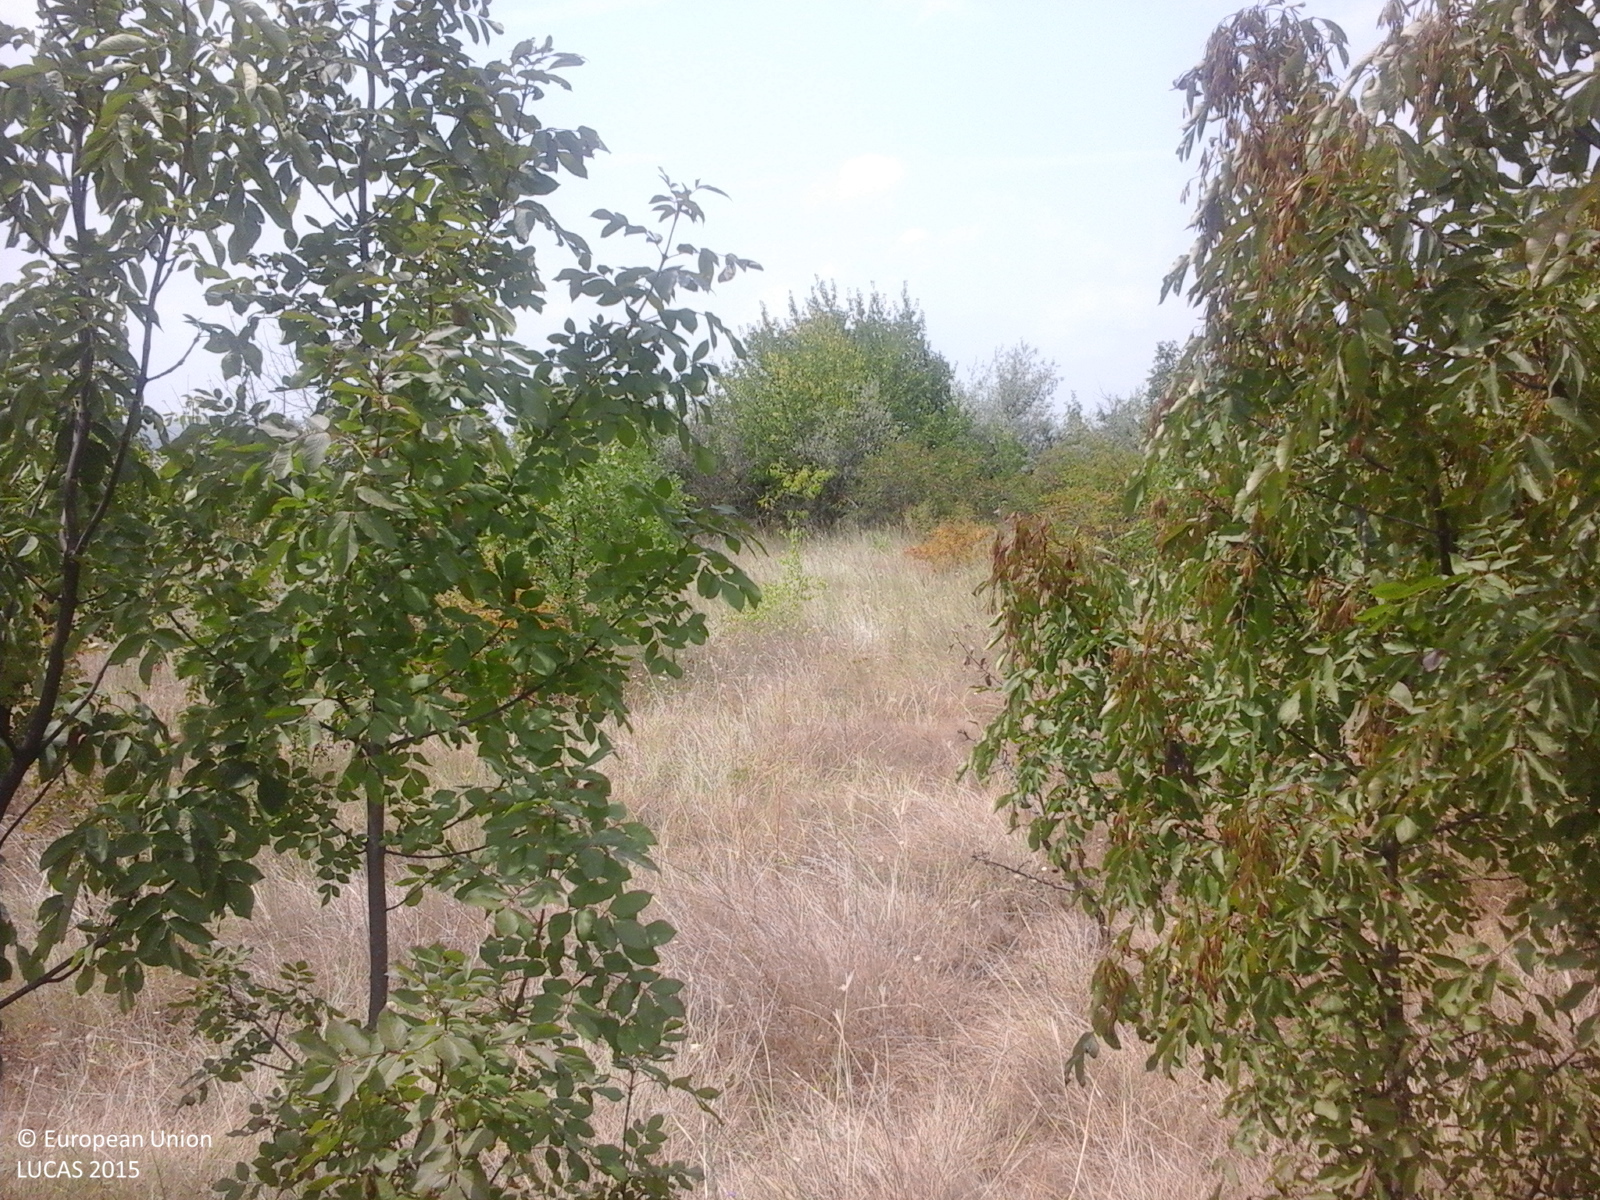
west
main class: Grassland
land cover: Grassland with sparse tree/shrub cover
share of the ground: > 75 %
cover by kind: herbaceous plants 95 %, broadleaved forest trees 5 %
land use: Fallow land
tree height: < 5 m
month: July
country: RO
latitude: 44.9033
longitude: 28.2948
